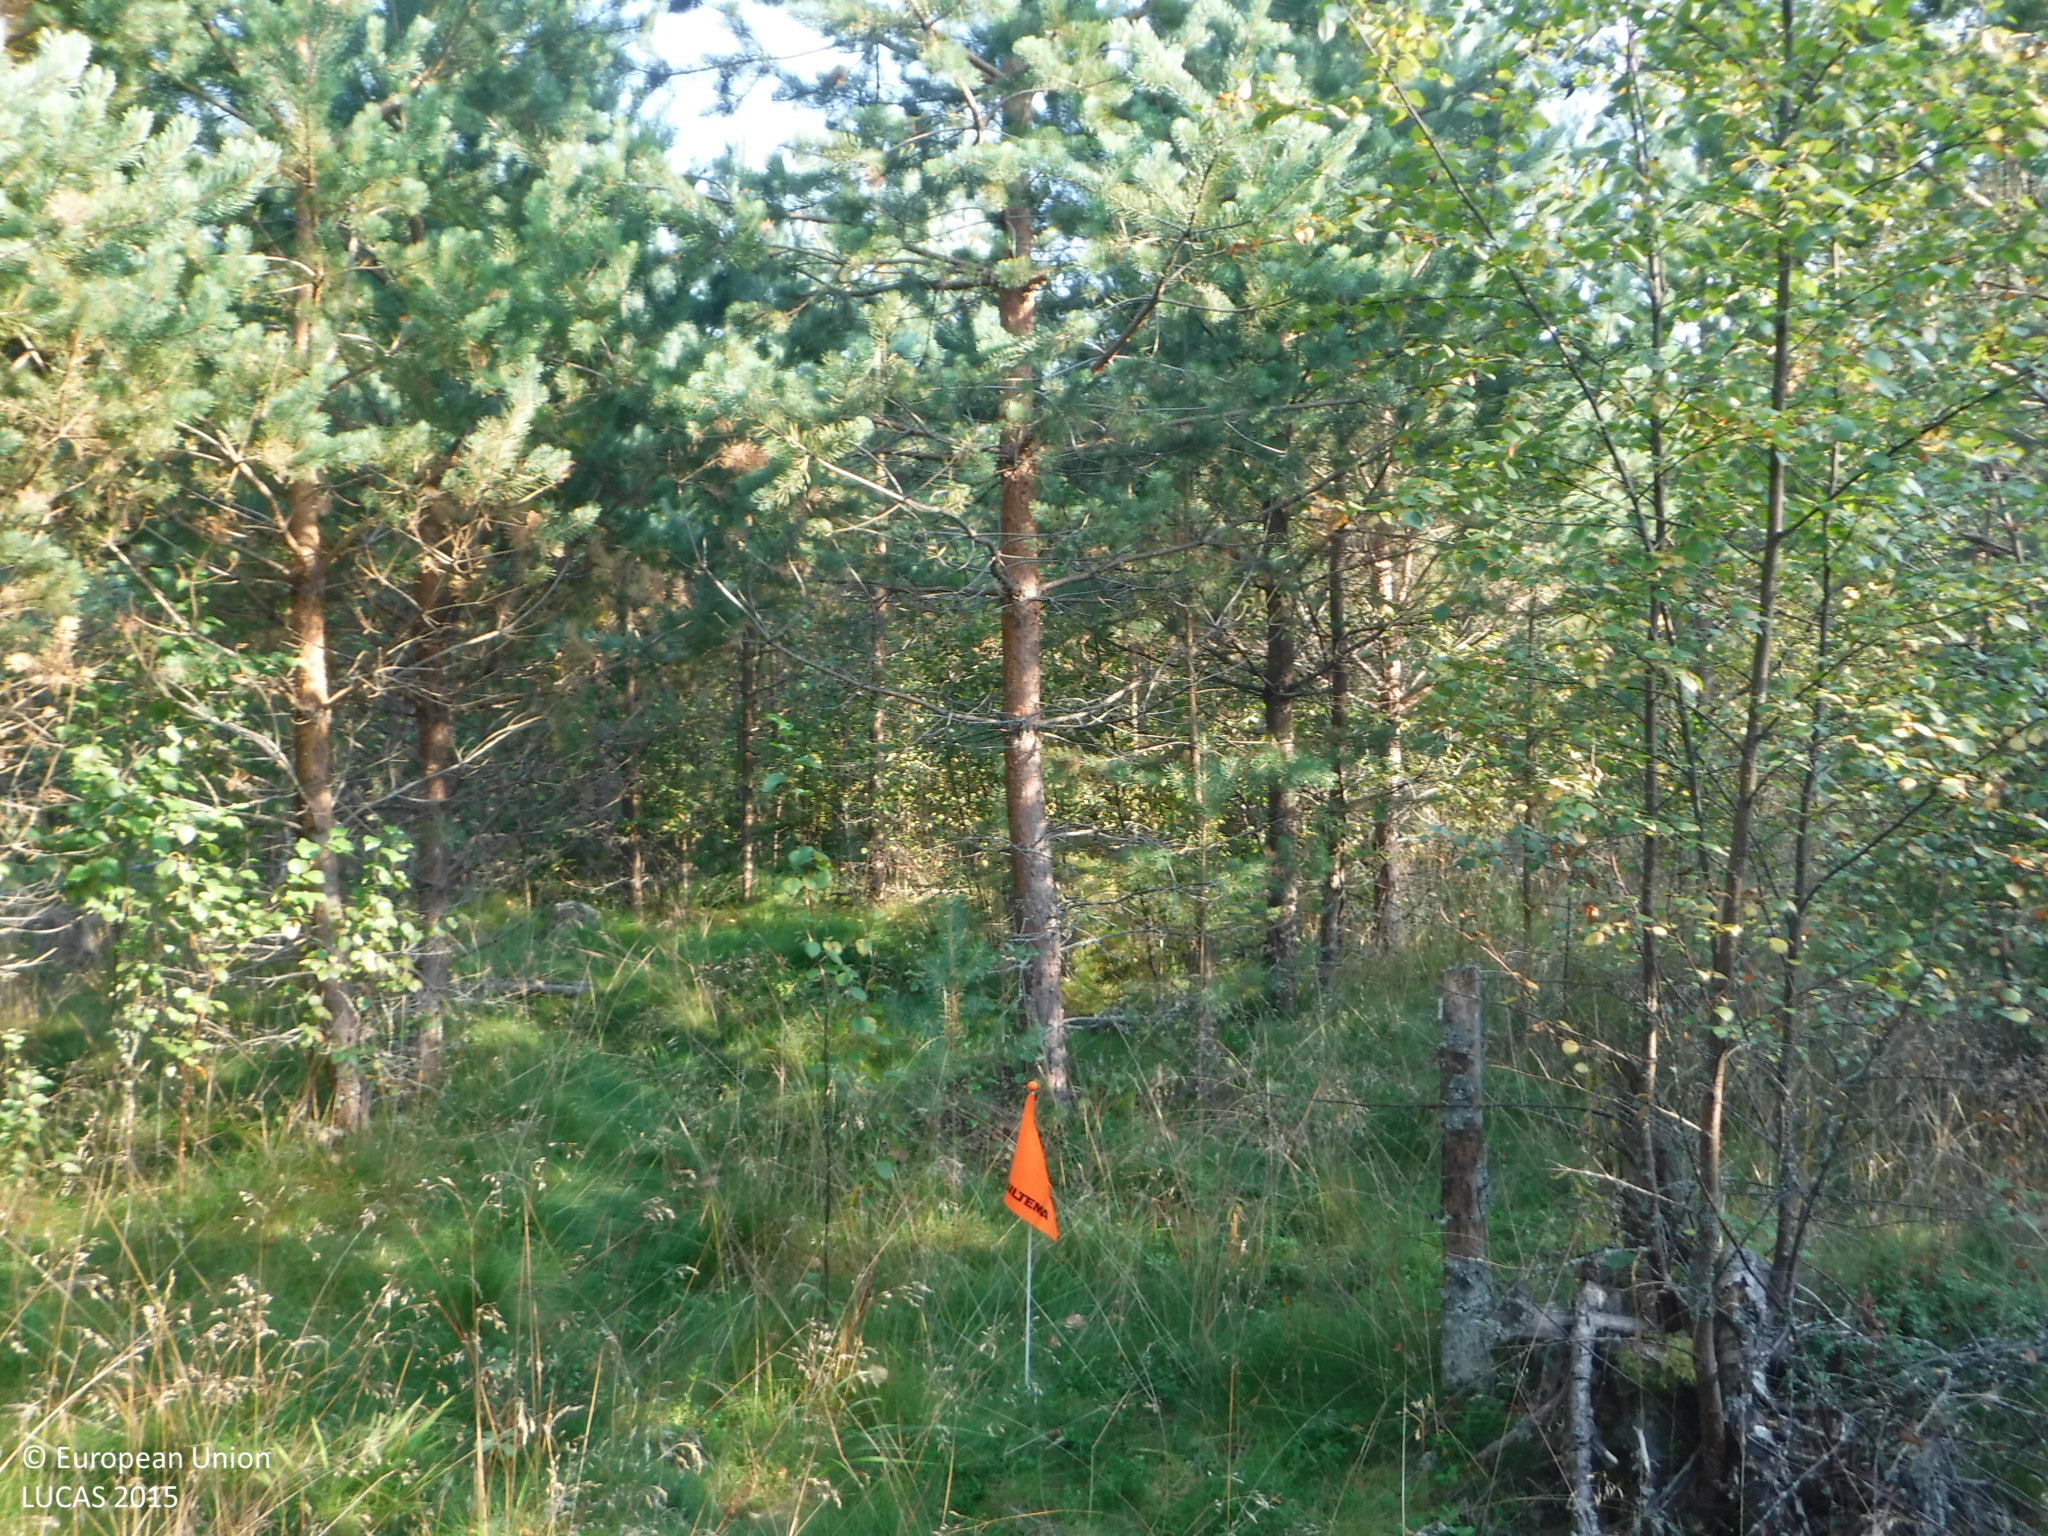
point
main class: Woodland
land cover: Pine dominated coniferous woodland
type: boreal forest
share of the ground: 25 - 50 %
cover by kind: herbaceous plants 50 %, coniferous forest trees 30 %, shrubs 10 %, broadleaved forest trees 5 %, lichens and mosses 5 %
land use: Forestry
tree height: > 5 m
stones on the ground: < 10 %
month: August
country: FI
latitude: 61.2559
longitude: 23.0287
